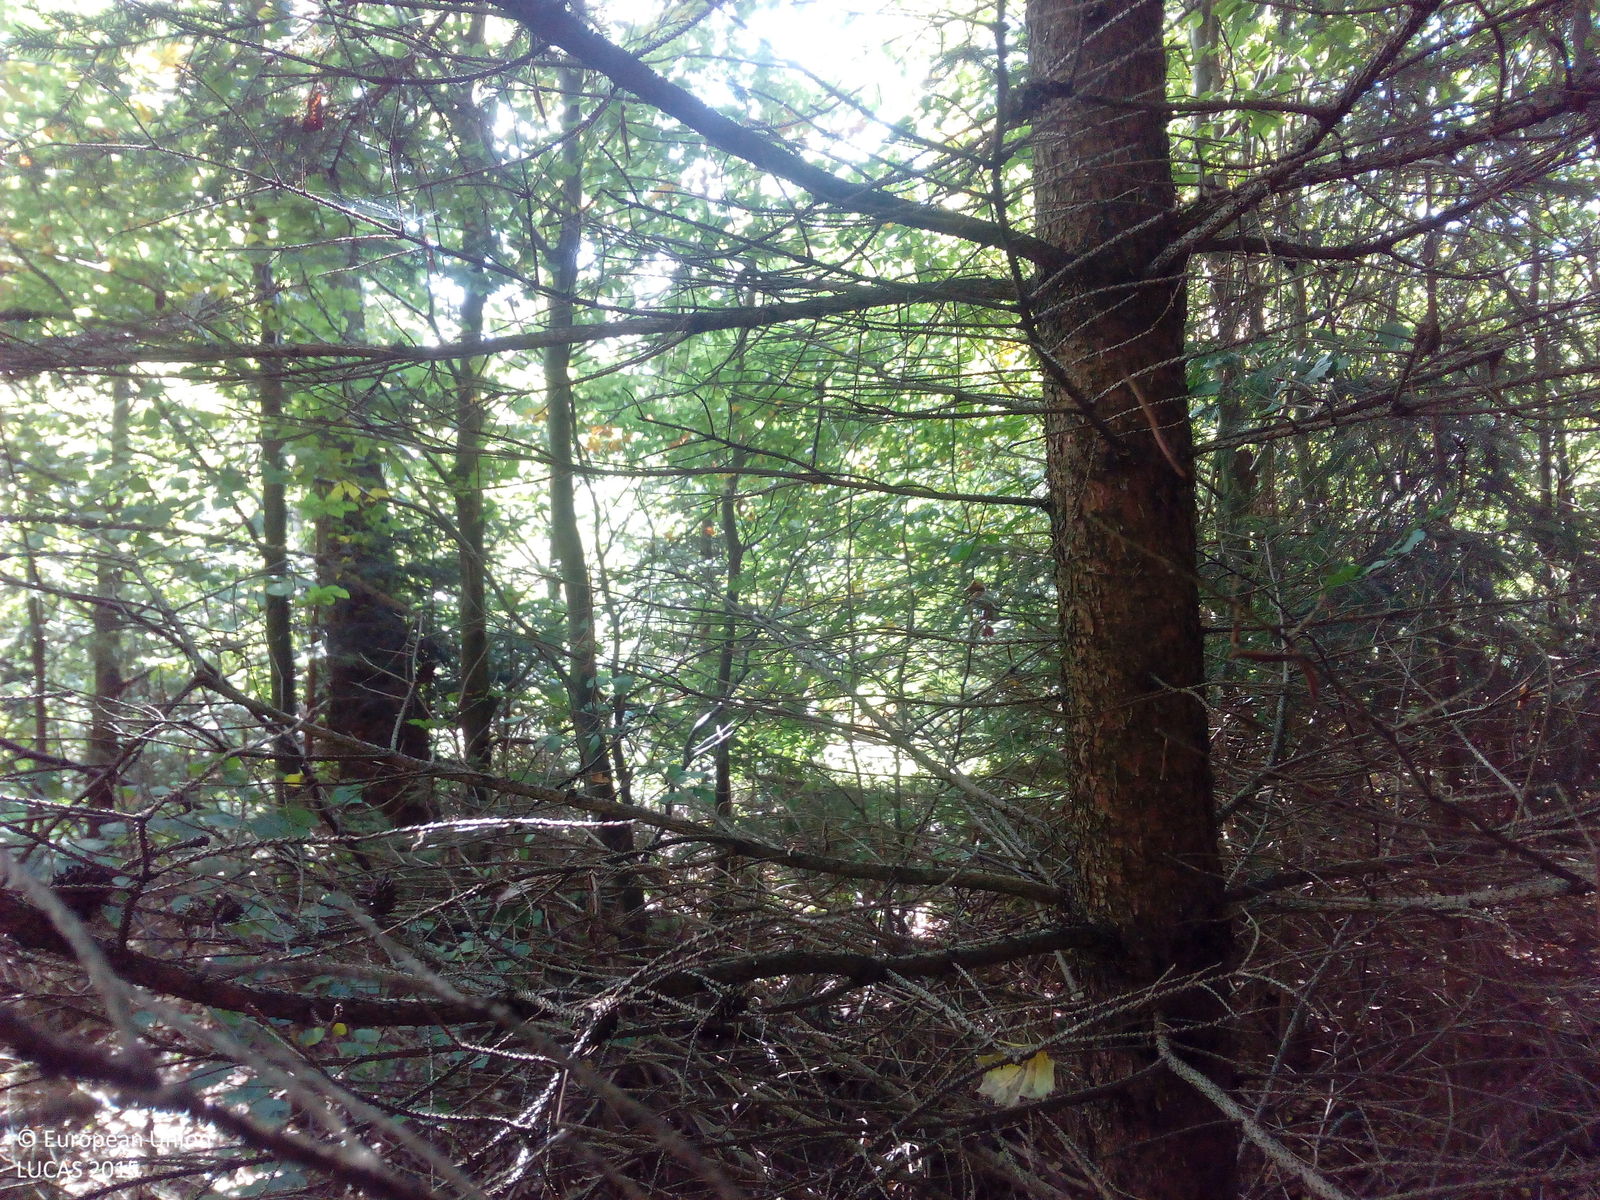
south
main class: Woodland
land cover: Spruce dominated coniferous woodland
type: hemiboreal forest and nemoral coniferous forest and mixed broadleaved-coniferous forest
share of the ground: > 75 %
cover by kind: coniferous forest trees 90 %, broadleaved forest trees 10 %
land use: Forestry
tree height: > 5 m
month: September
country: DE
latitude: 51.7837
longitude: 9.6377
